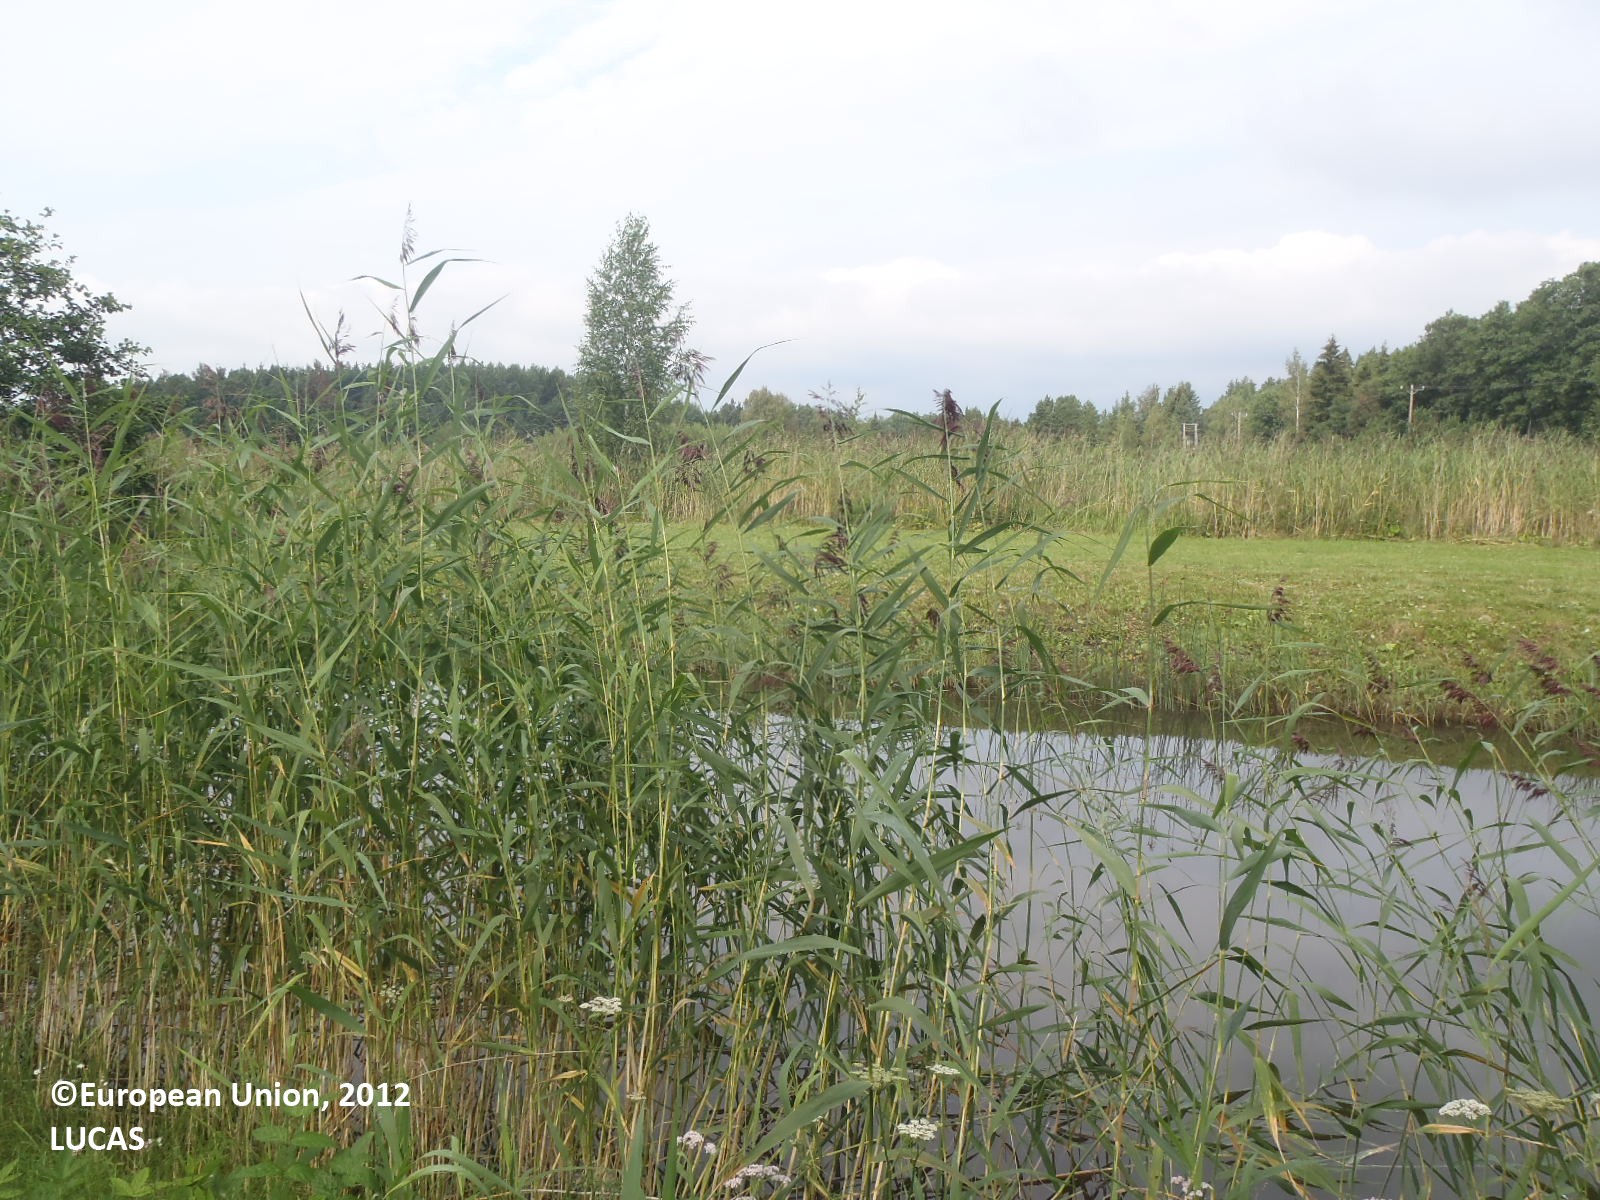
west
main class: Grassland
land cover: Grassland without tree/shrub cover
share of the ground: > 75 %
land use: Amenities, museums, leisure
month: July
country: FI
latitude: 60.5567
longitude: 21.8235
